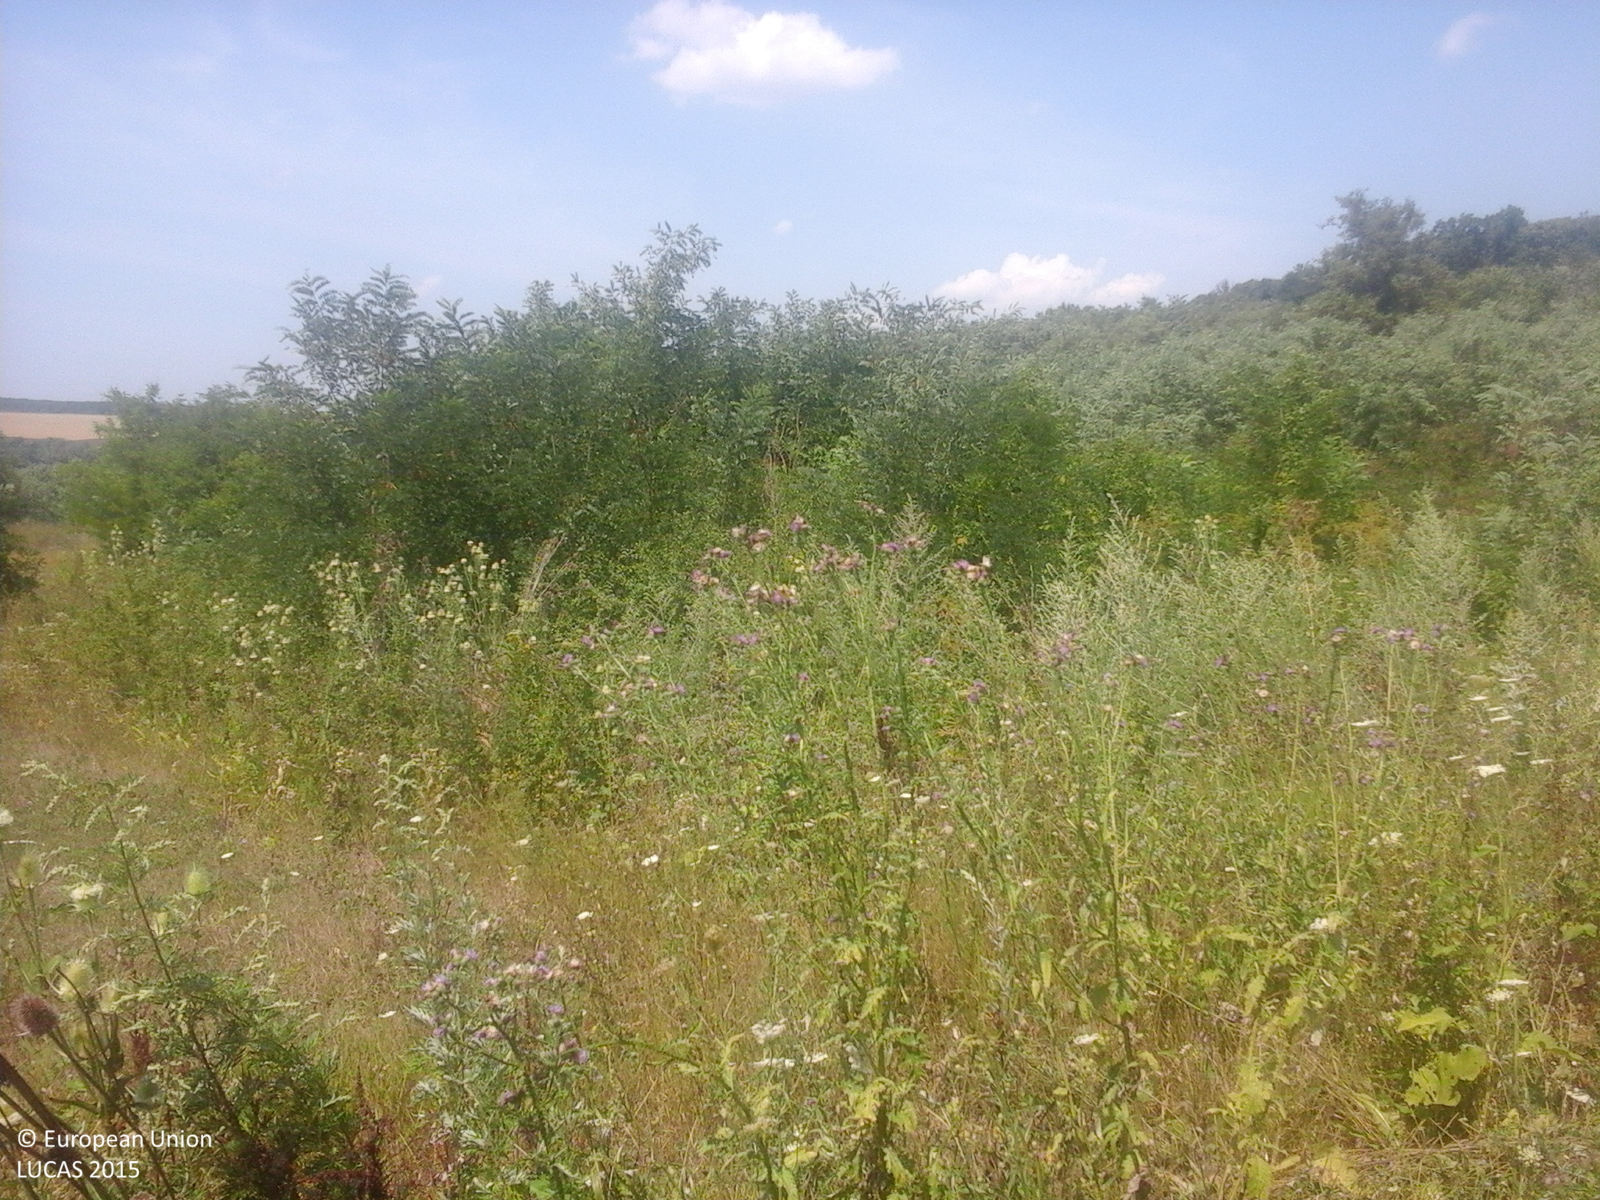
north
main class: Woodland
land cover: Broadleaved woodland
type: broadleaved evergreen forest
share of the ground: > 75 %
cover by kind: broadleaved forest trees 100 %
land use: Forestry
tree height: > 5 m
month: July
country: RO
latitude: 46.6532
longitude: 27.9899
